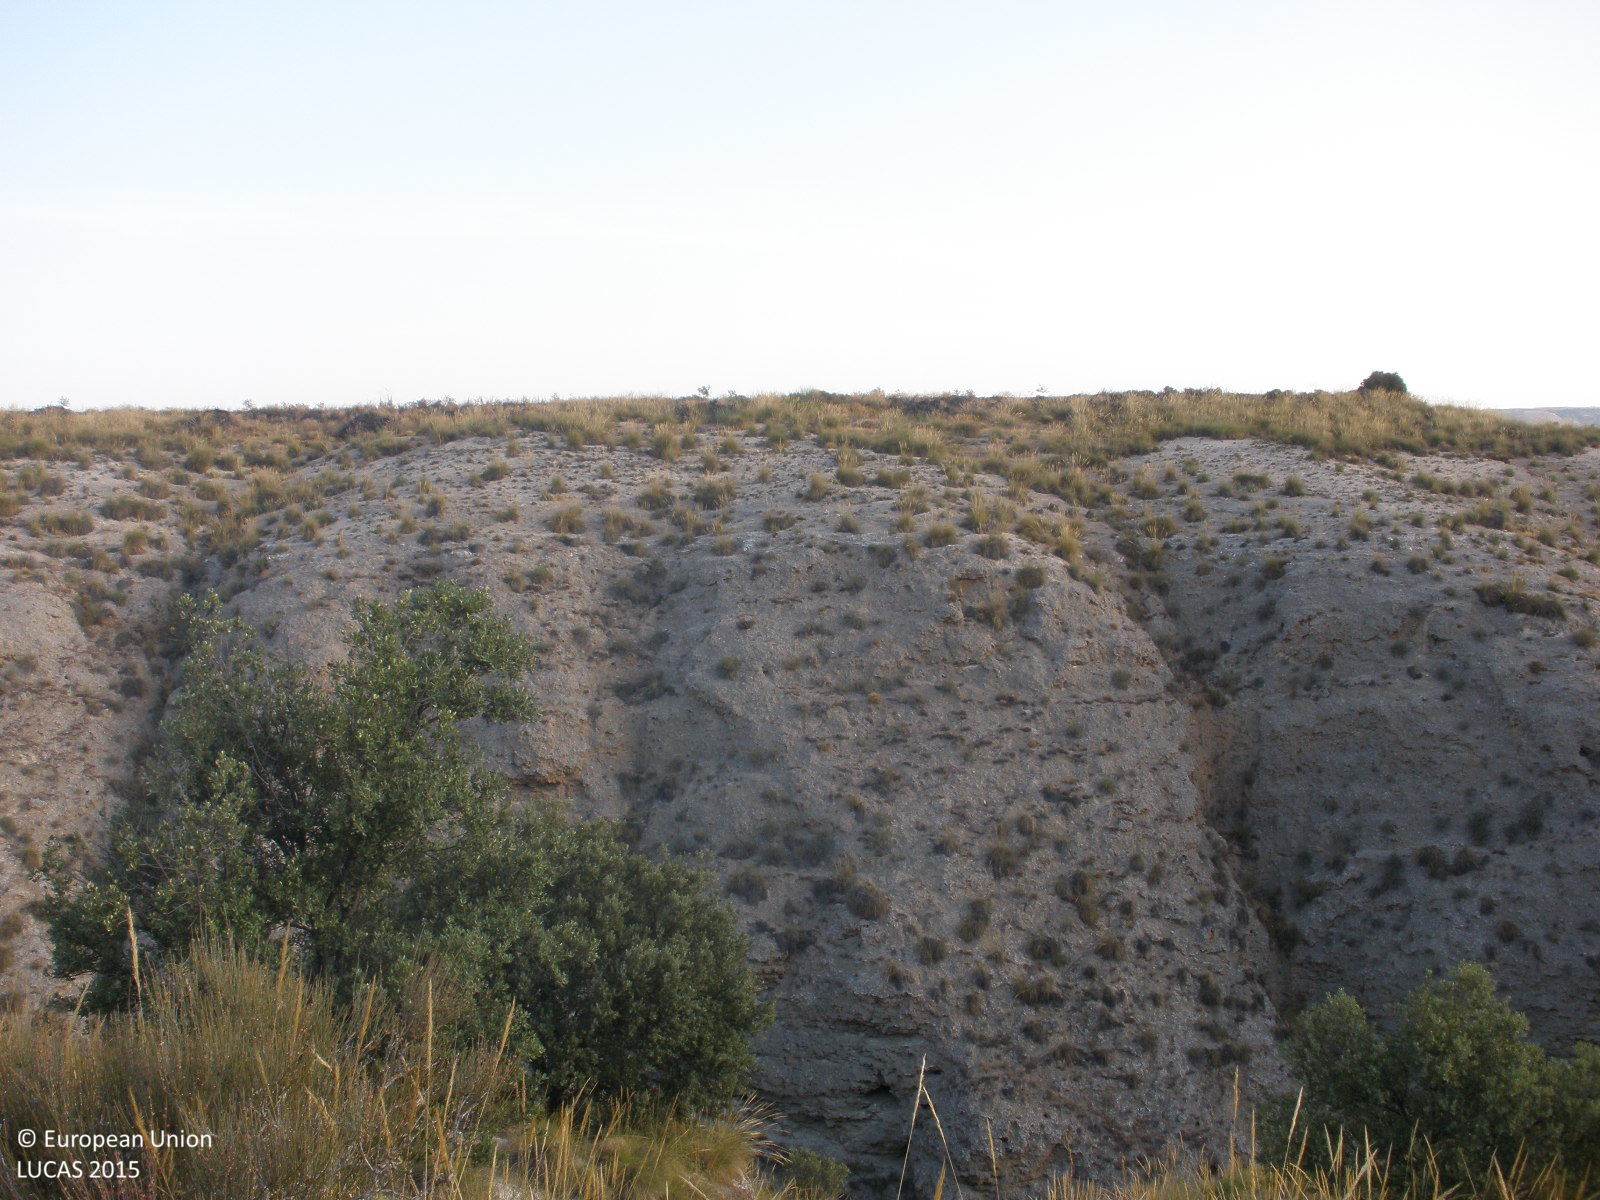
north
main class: Woodland
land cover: Broadleaved woodland
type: broadleaved evergreen forest
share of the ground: 10 - 25 %
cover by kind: shrubs 40 %, herbaceous plants 30 %, broadleaved forest trees 20 %, consolidated bare surface 10 %
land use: Semi-natural and natural areas not in use
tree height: < 5 m
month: July
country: ES
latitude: 40.0214
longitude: -3.3975
